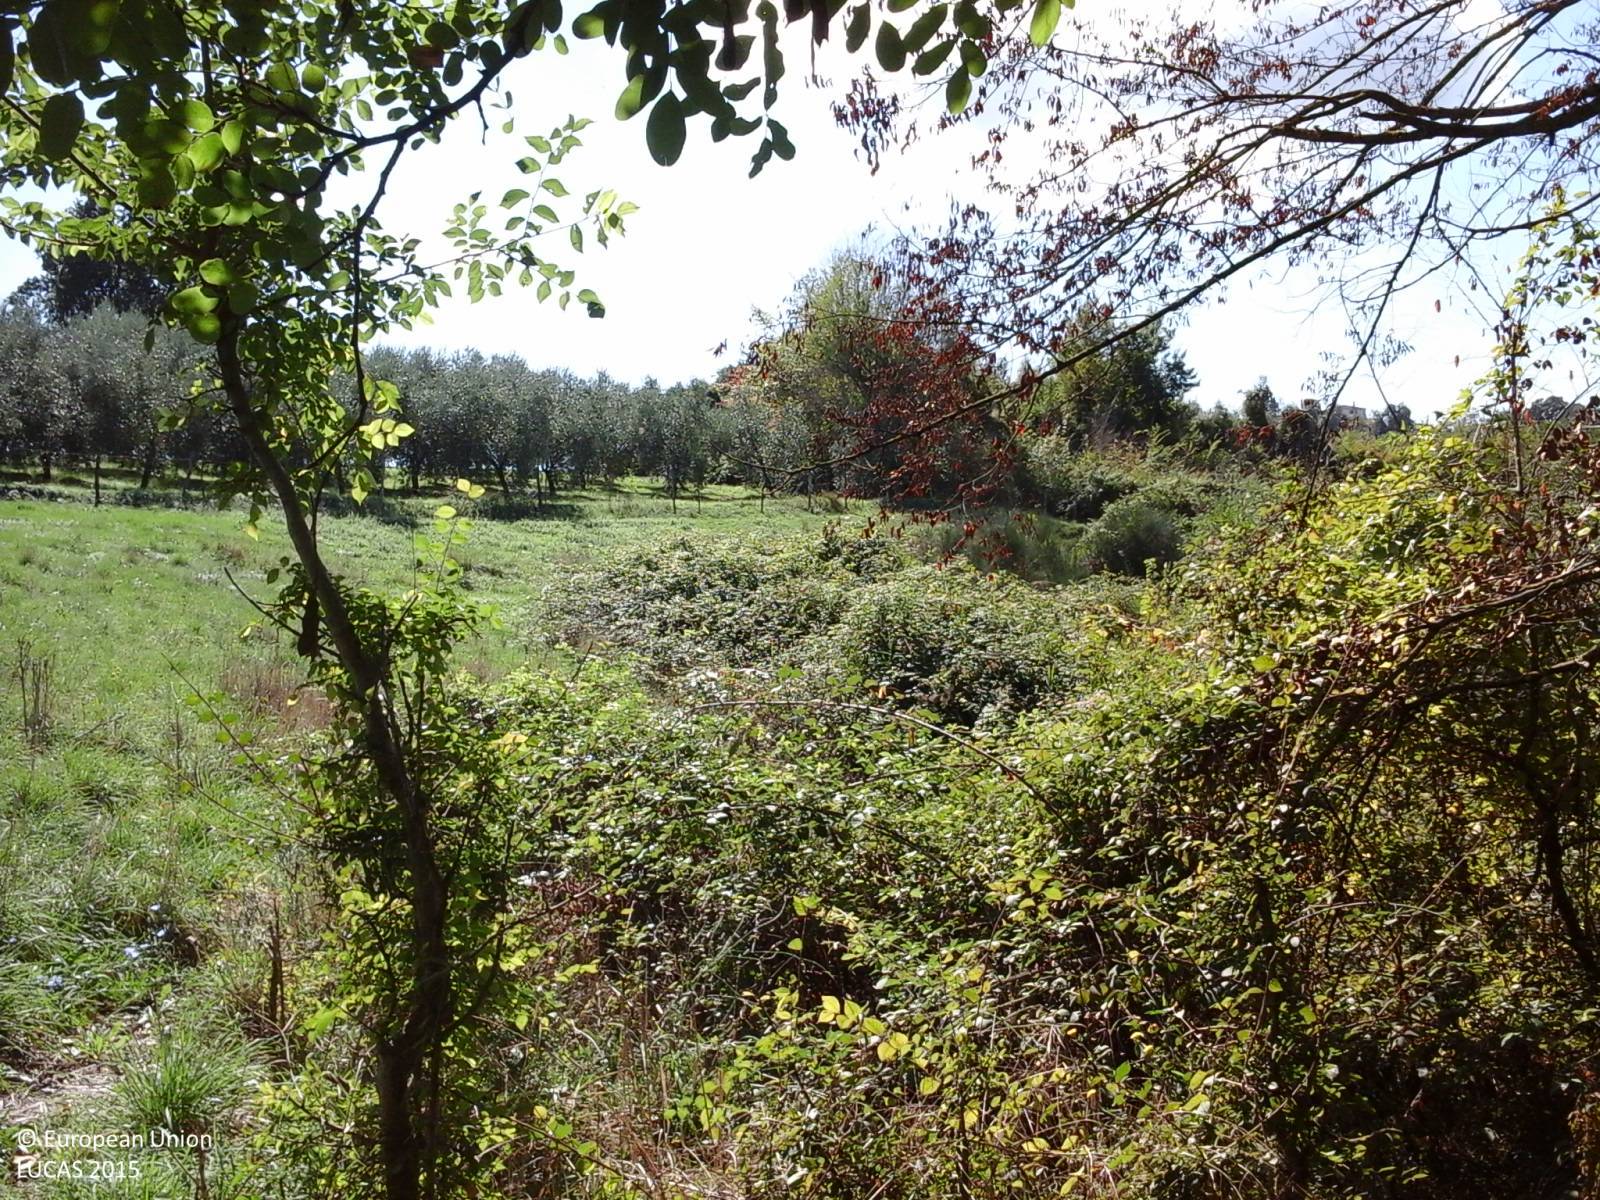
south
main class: Woodland
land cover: Broadleaved woodland
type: thermophilous deciduous forest
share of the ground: > 75 %
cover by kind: broadleaved forest trees 90 %, shrubs 10 %
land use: Abandoned areas
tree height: > 5 m
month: September
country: IT
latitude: 42.3135
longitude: 12.5996
